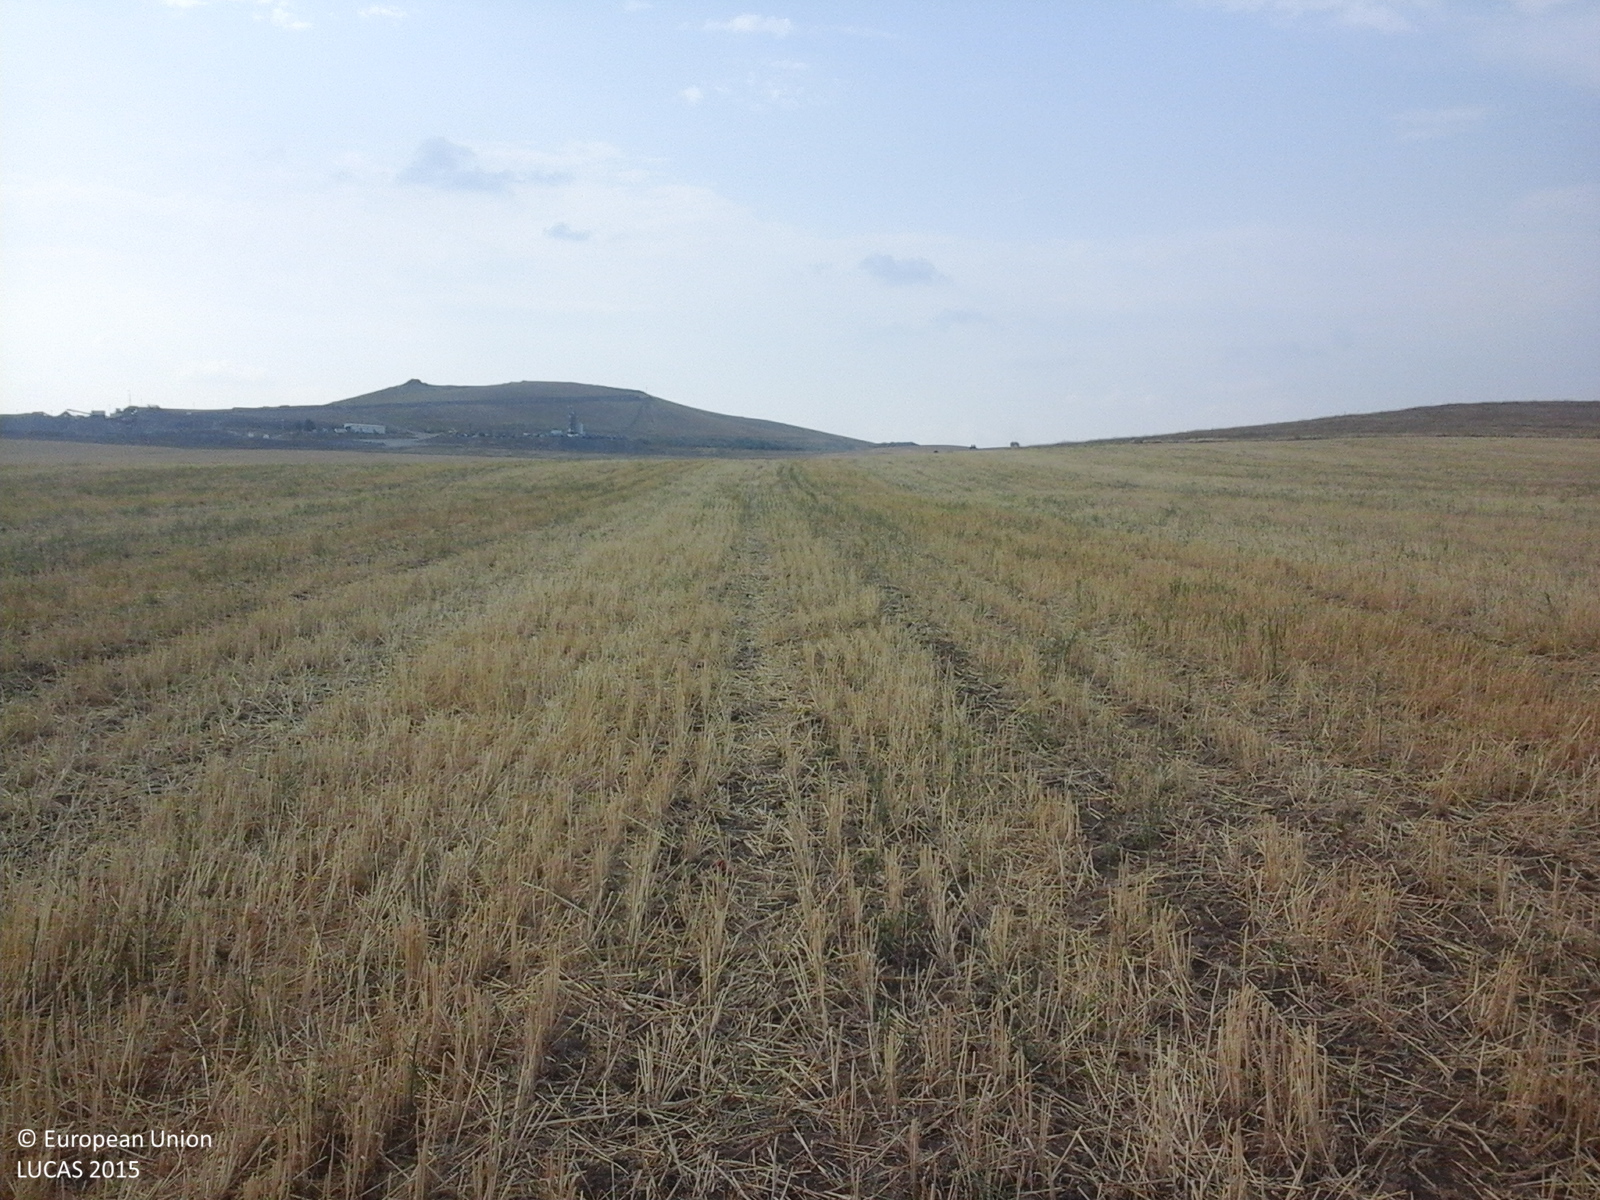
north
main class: Cropland
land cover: Common wheat
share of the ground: > 75 %
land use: Agriculture (excluding fallow land and kitchen gardens)
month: July
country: RO
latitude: 45.0950
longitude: 28.2545
